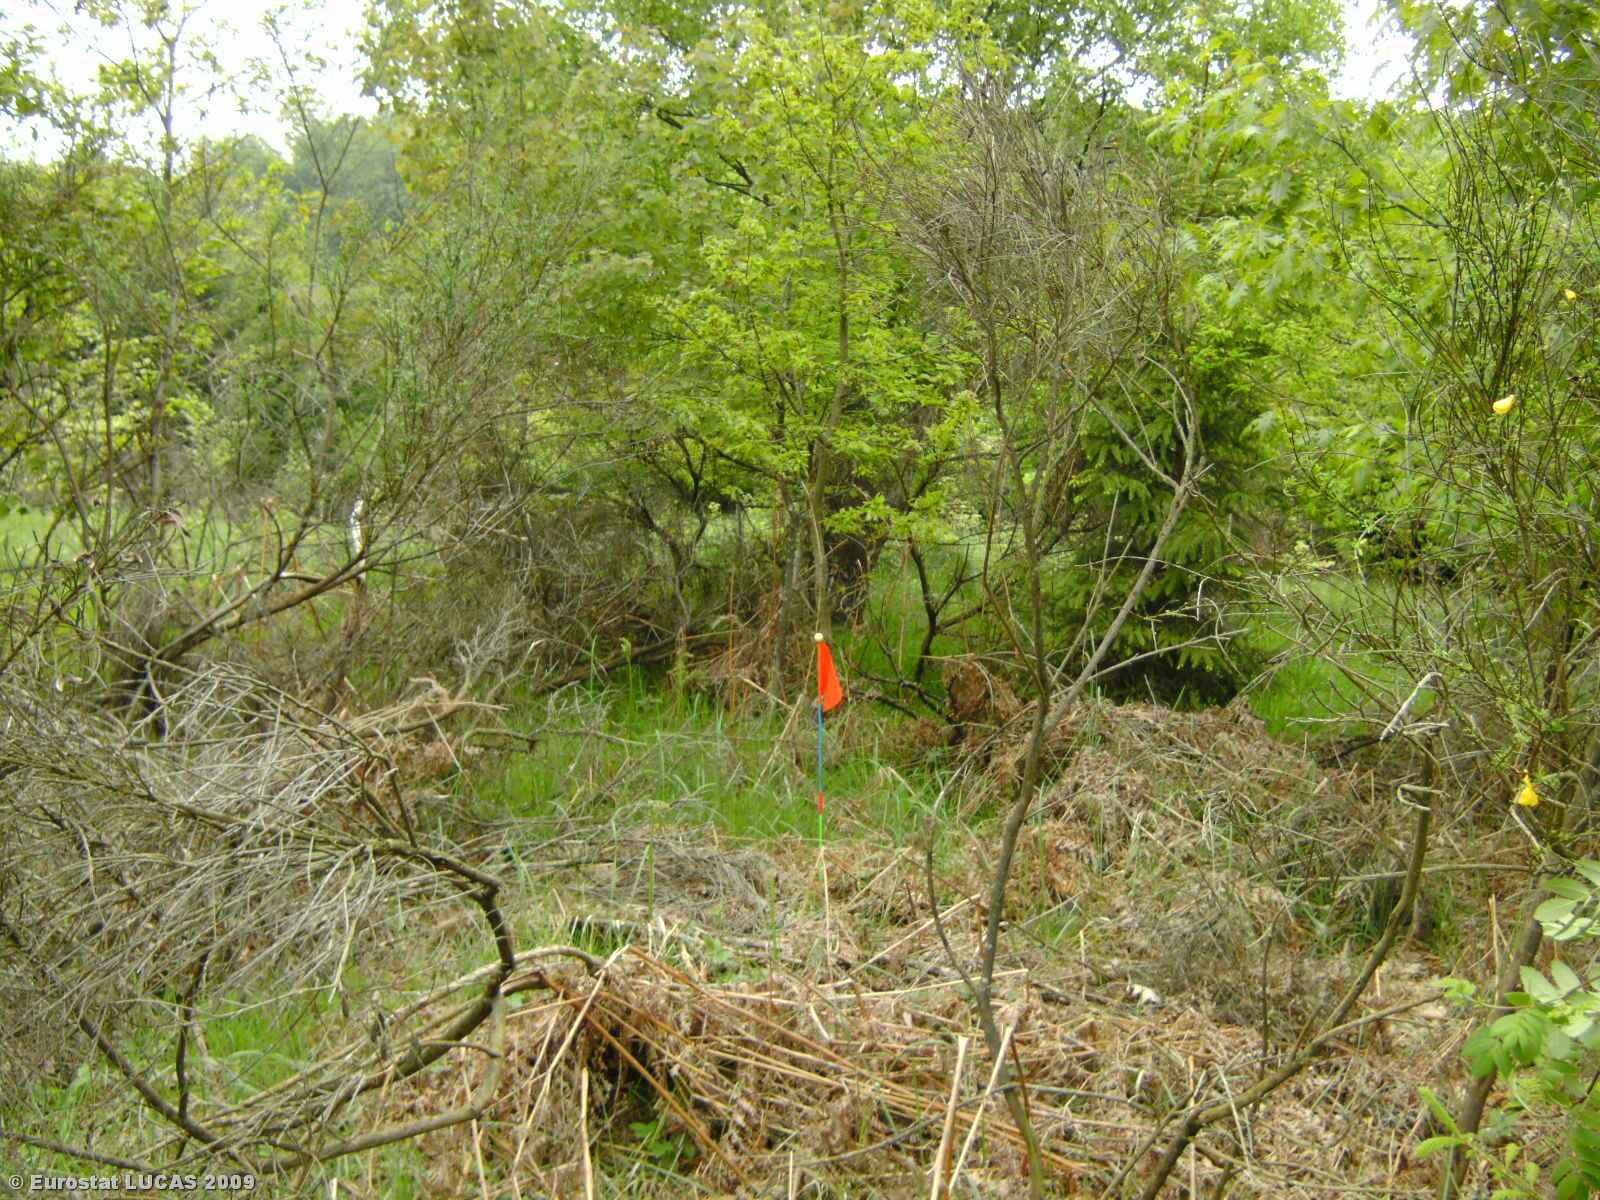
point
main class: Woodland
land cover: Broadleaved woodland
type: hemiboreal forest and nemoral coniferous forest and mixed broadleaved-coniferous forest
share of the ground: 50 - 75 %
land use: Forestry
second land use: Amenities, museums, leisure
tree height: > 5 m
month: May
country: LU
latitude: 49.6894
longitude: 6.2152
